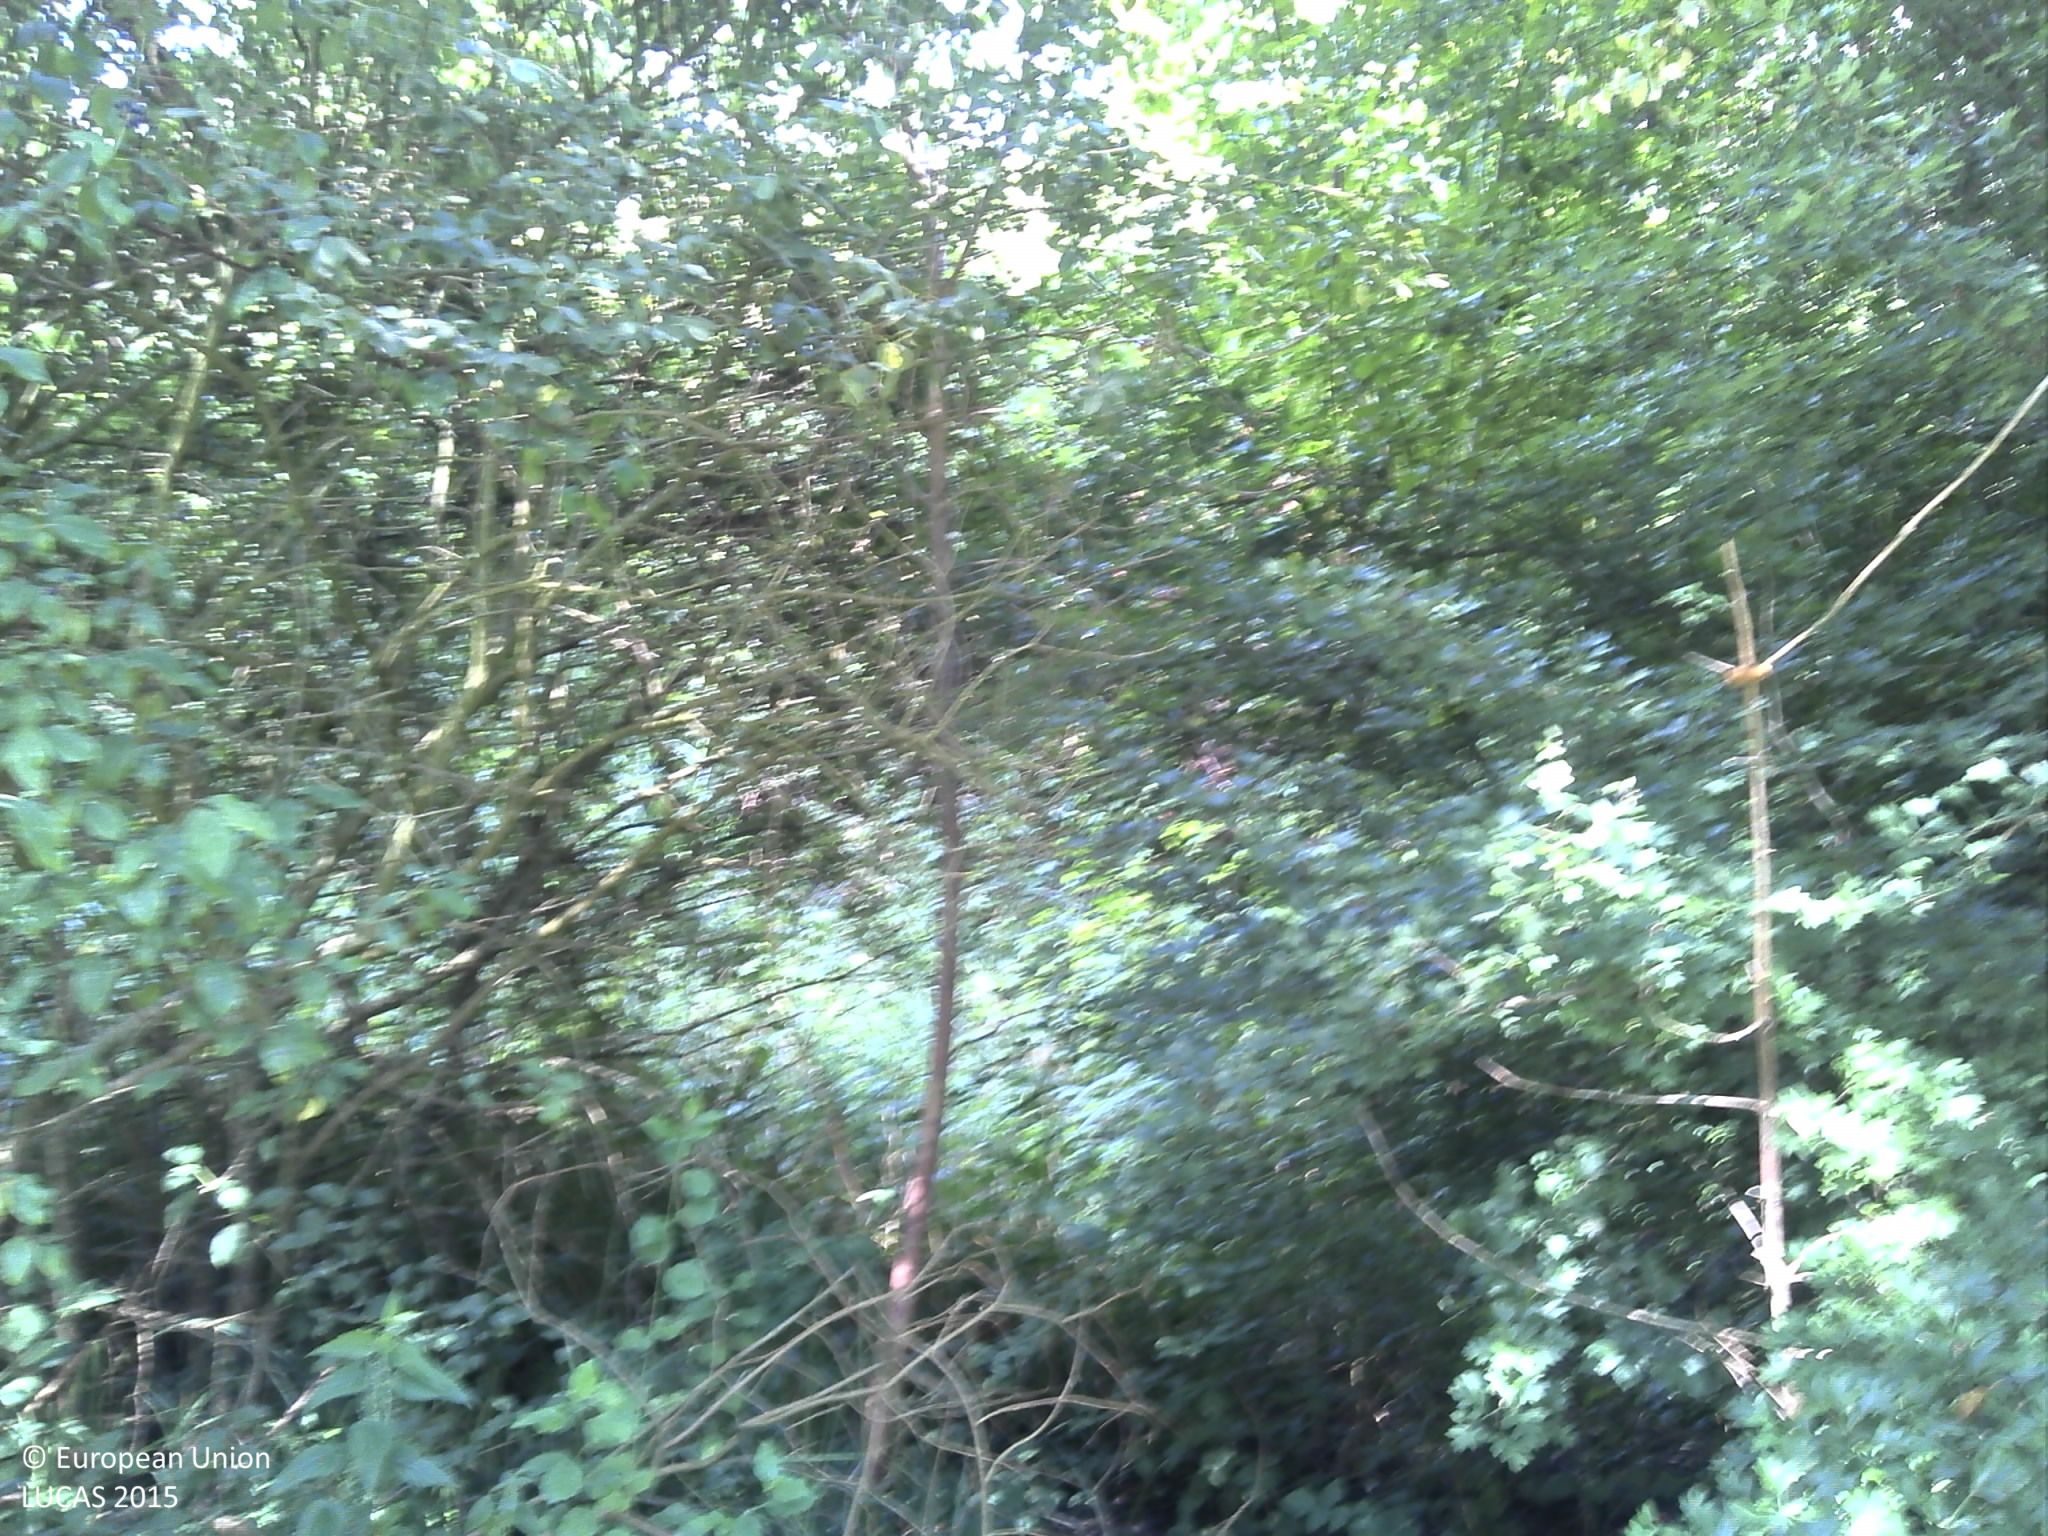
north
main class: Woodland
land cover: Broadleaved woodland
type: exotic forest
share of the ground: > 75 %
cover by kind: broadleaved forest trees 70 %, herbaceous plants 30 %
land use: Forestry
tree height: > 5 m
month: August
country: FR
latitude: 48.4806
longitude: 3.4596
